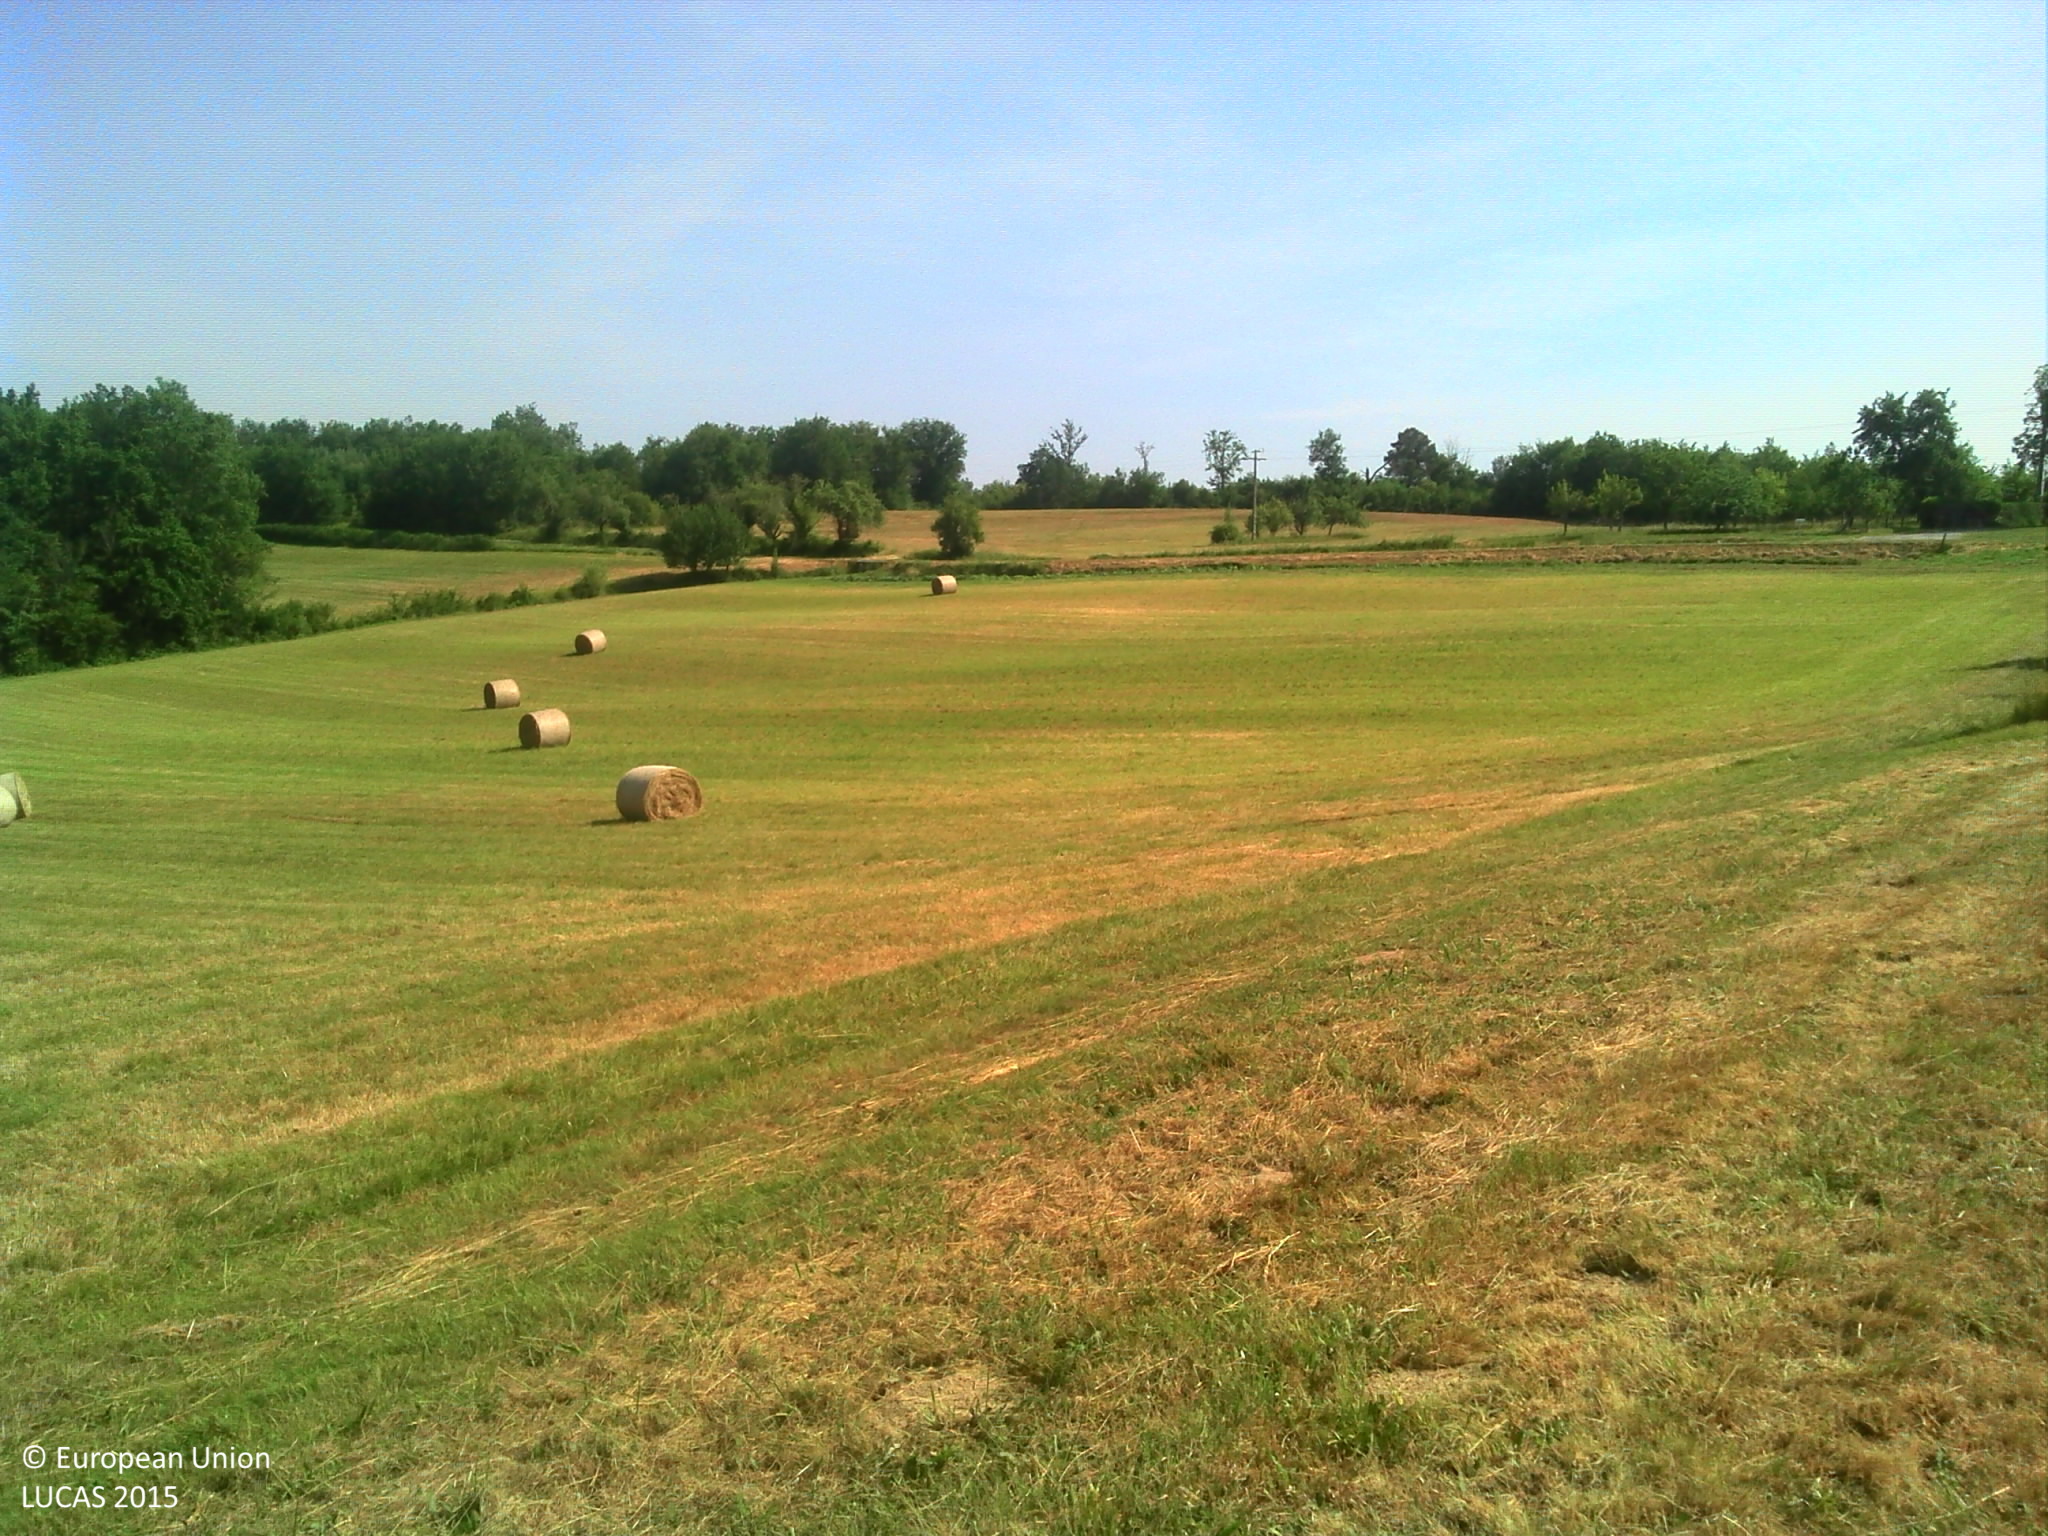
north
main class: Grassland
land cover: Grassland without tree/shrub cover
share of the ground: > 75 %
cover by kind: herbaceous plants 100 %
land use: Agriculture (excluding fallow land and kitchen gardens)
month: June
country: FR
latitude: 43.9624
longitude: 1.6890
